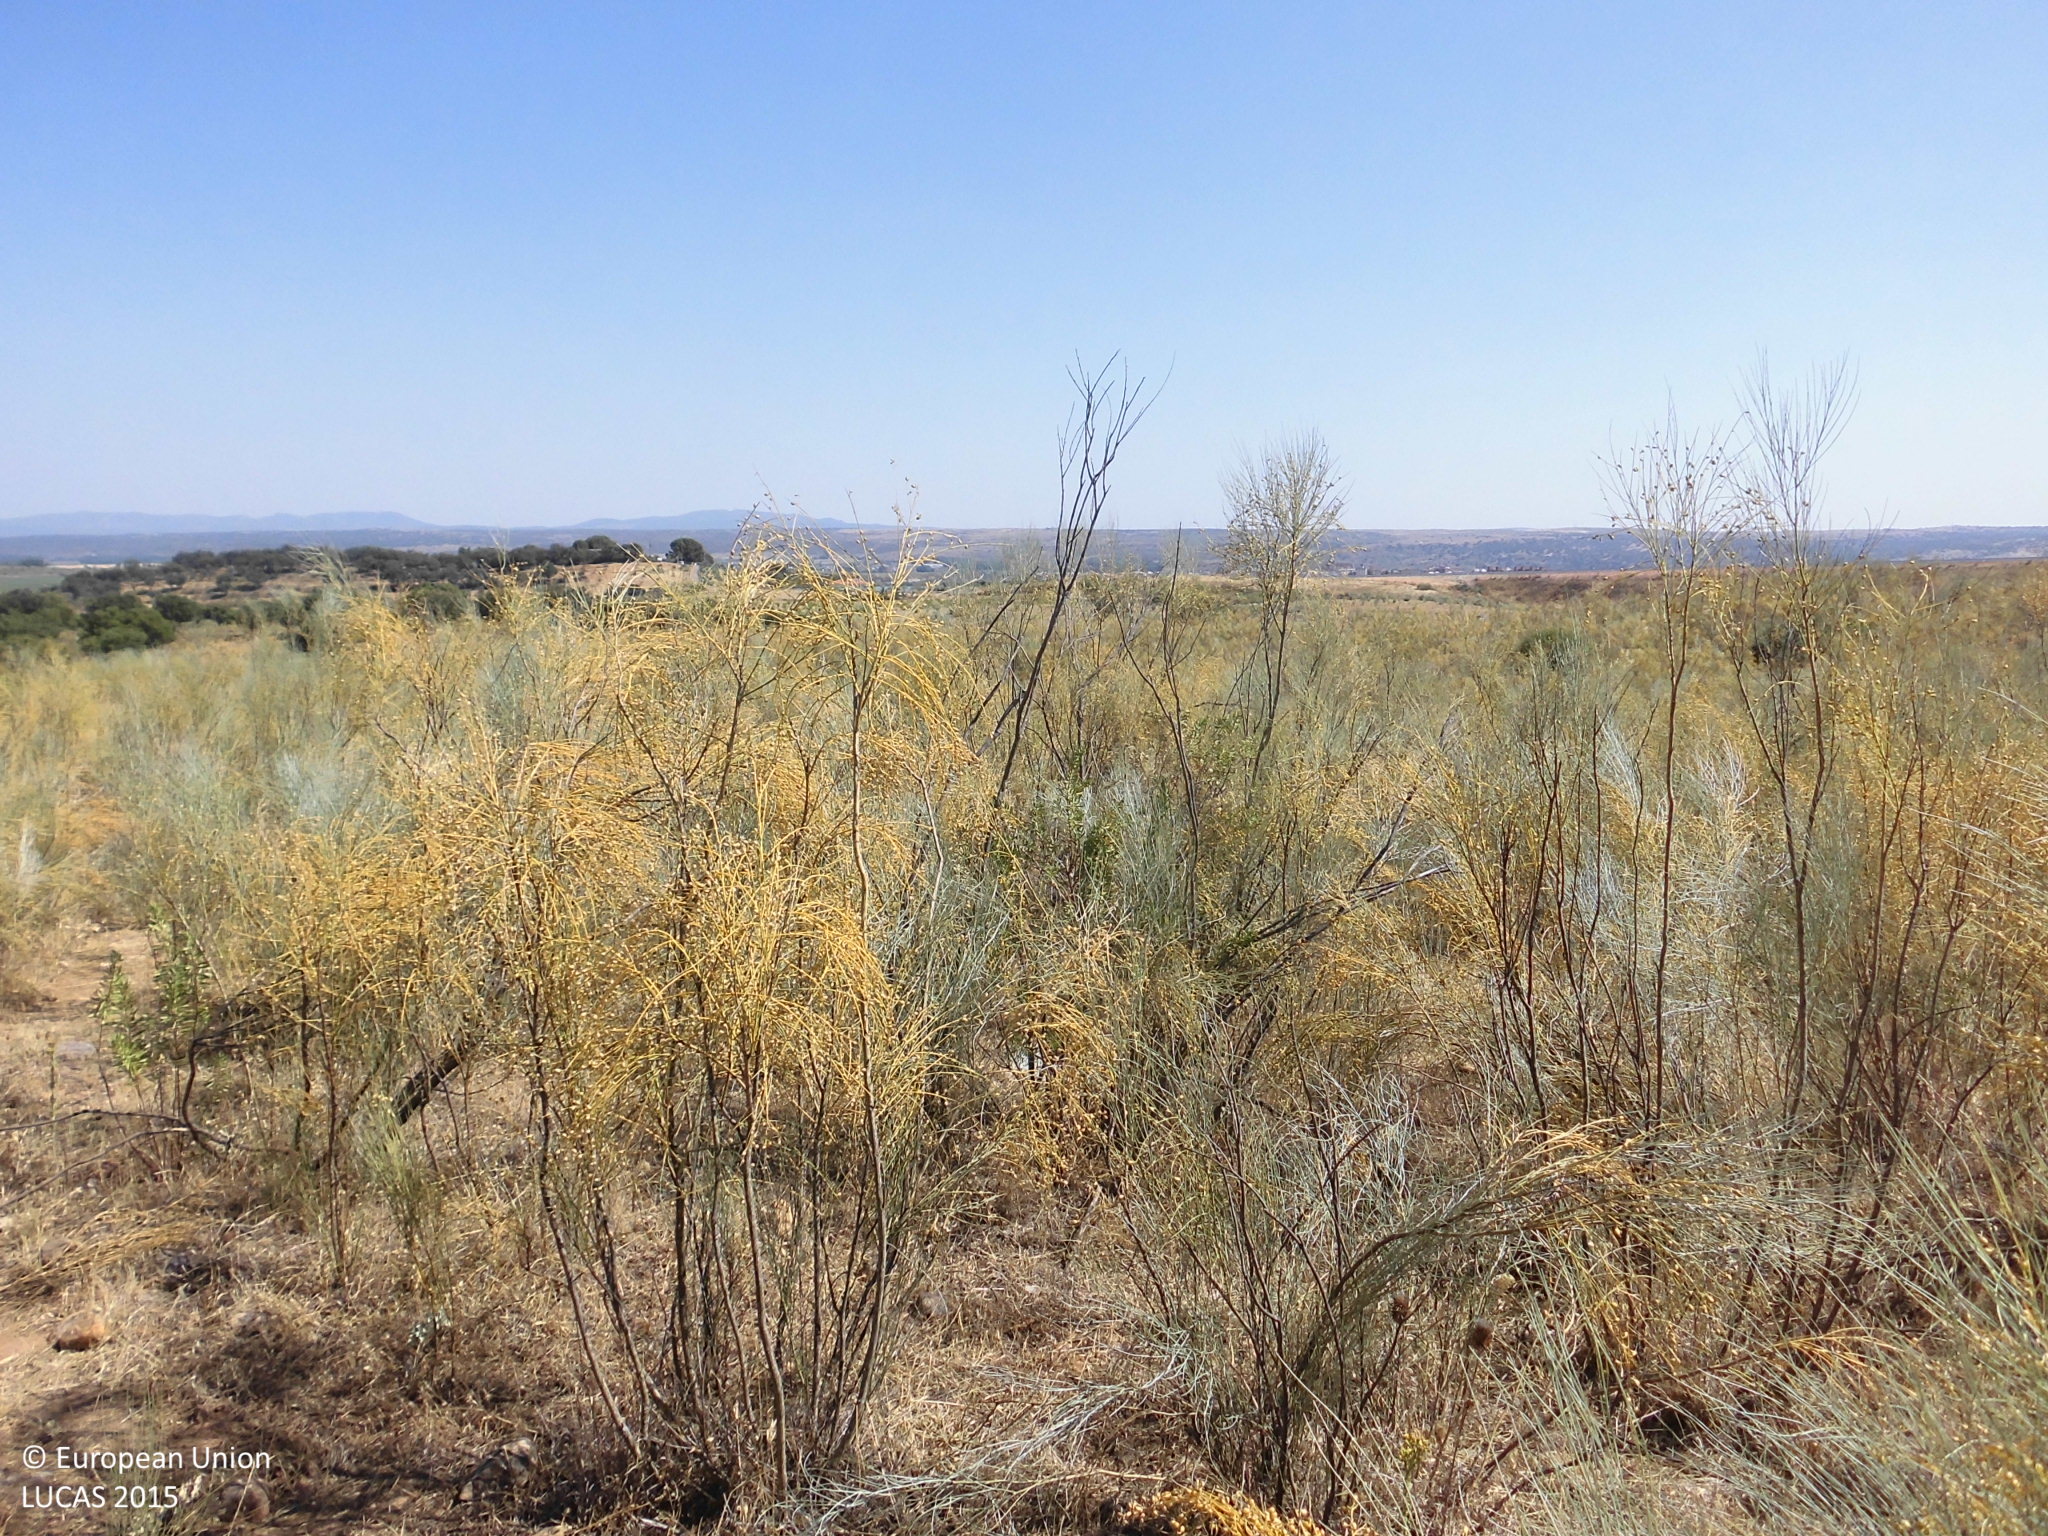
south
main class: Shrubland
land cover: Shrubland without tree cover
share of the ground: 50 - 75 %
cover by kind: shrubs 75 %, herbaceous plants 25 %
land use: Agriculture (excluding fallow land and kitchen gardens)
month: July
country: ES
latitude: 40.0129
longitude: -6.5408
